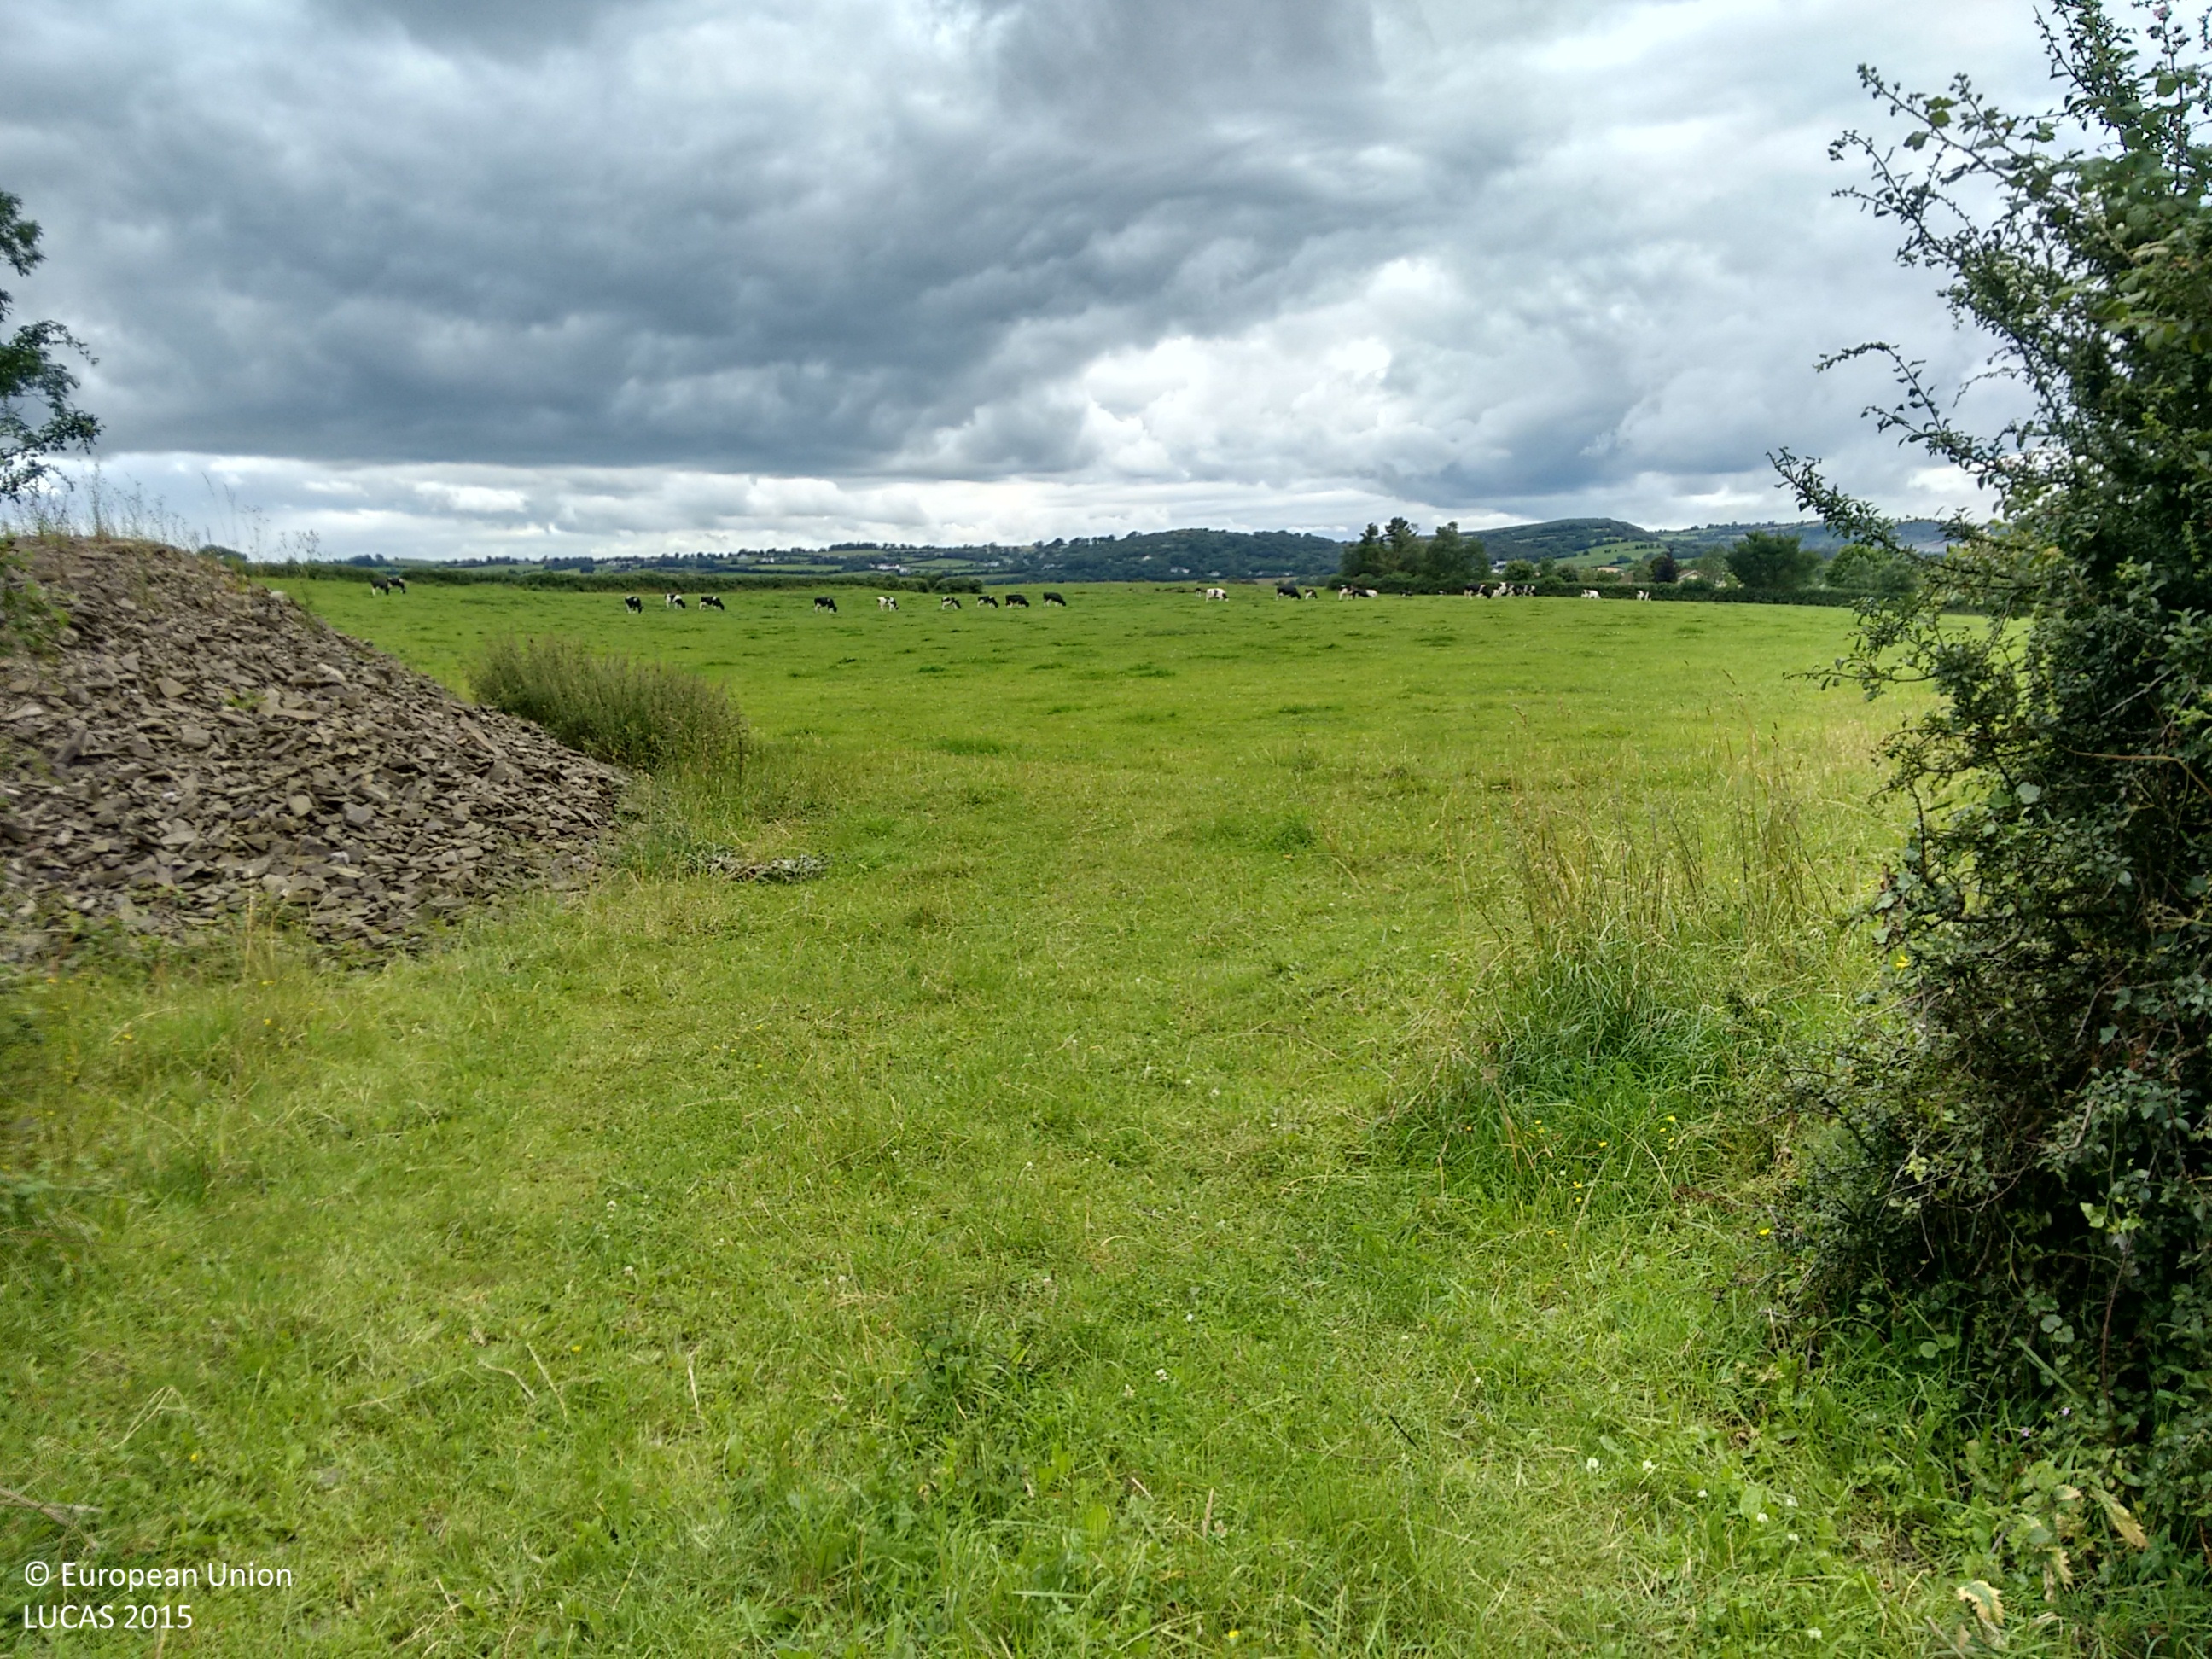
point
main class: Grassland
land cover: Grassland without tree/shrub cover
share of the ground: > 75 %
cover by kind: herbaceous plants 100 %
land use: Agriculture (excluding fallow land and kitchen gardens)
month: July
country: IE
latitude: 52.7164
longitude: -7.2795
